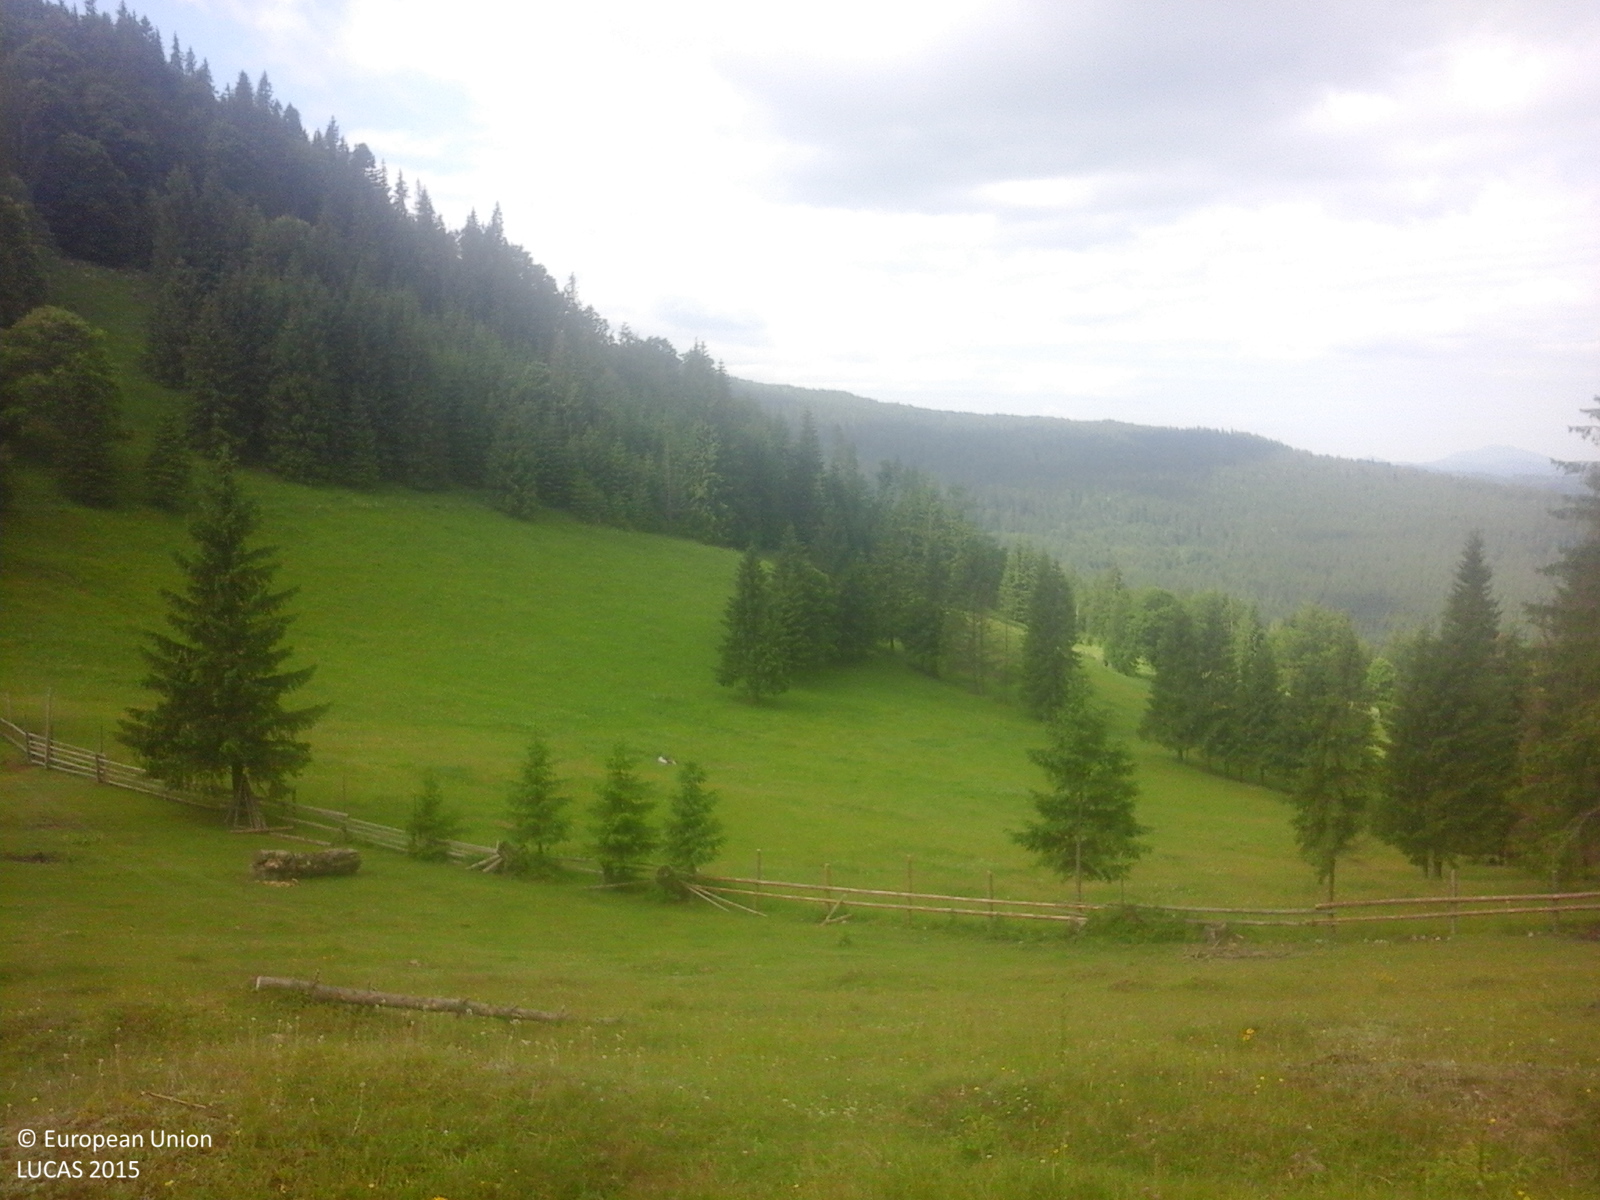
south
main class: Grassland
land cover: Grassland without tree/shrub cover
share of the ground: > 75 %
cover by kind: herbaceous plants 100 %
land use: Agriculture (excluding fallow land and kitchen gardens)
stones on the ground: < 10 %
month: June
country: RO
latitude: 47.3321
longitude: 25.2883
